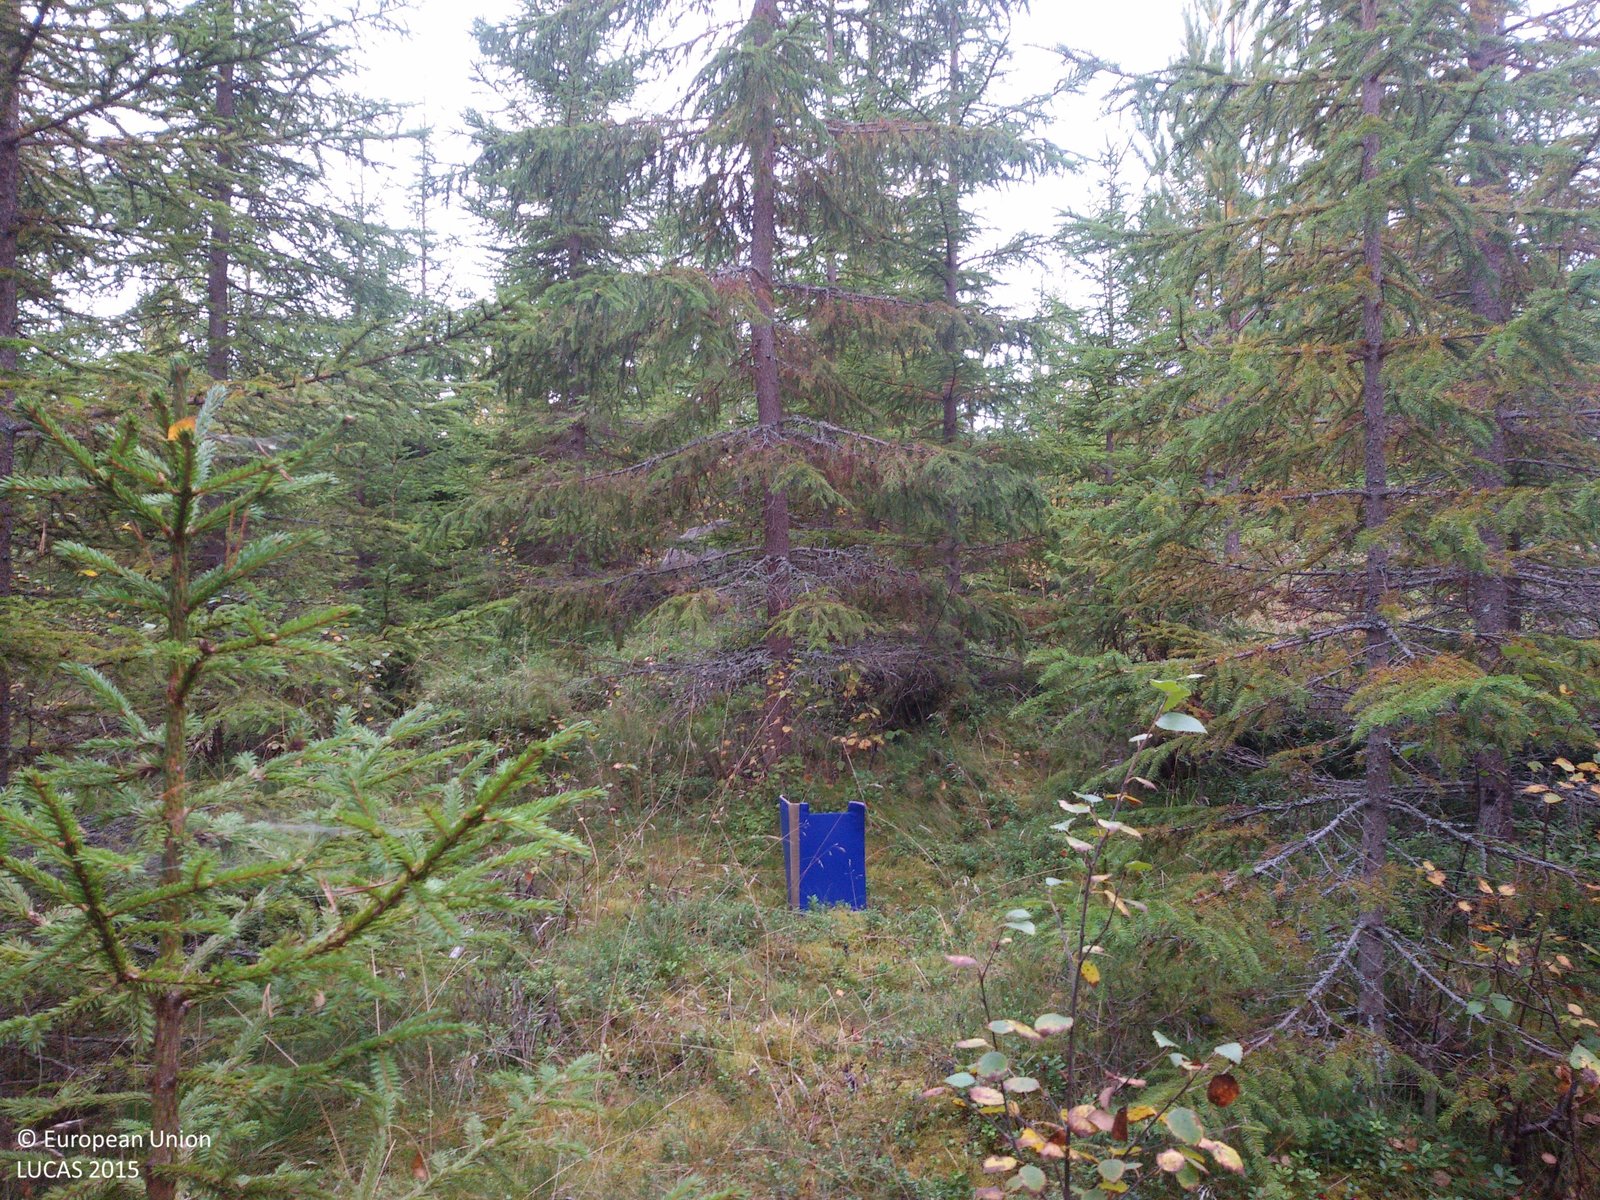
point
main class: Woodland
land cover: Spruce dominated coniferous woodland
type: boreal forest
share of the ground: 50 - 75 %
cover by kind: coniferous forest trees 70 %, lichens and mosses 15 %, shrubs 10 %, herbaceous plants 5 %
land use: Forestry
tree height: > 5 m
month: September
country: SE
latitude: 60.6880
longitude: 14.9863
